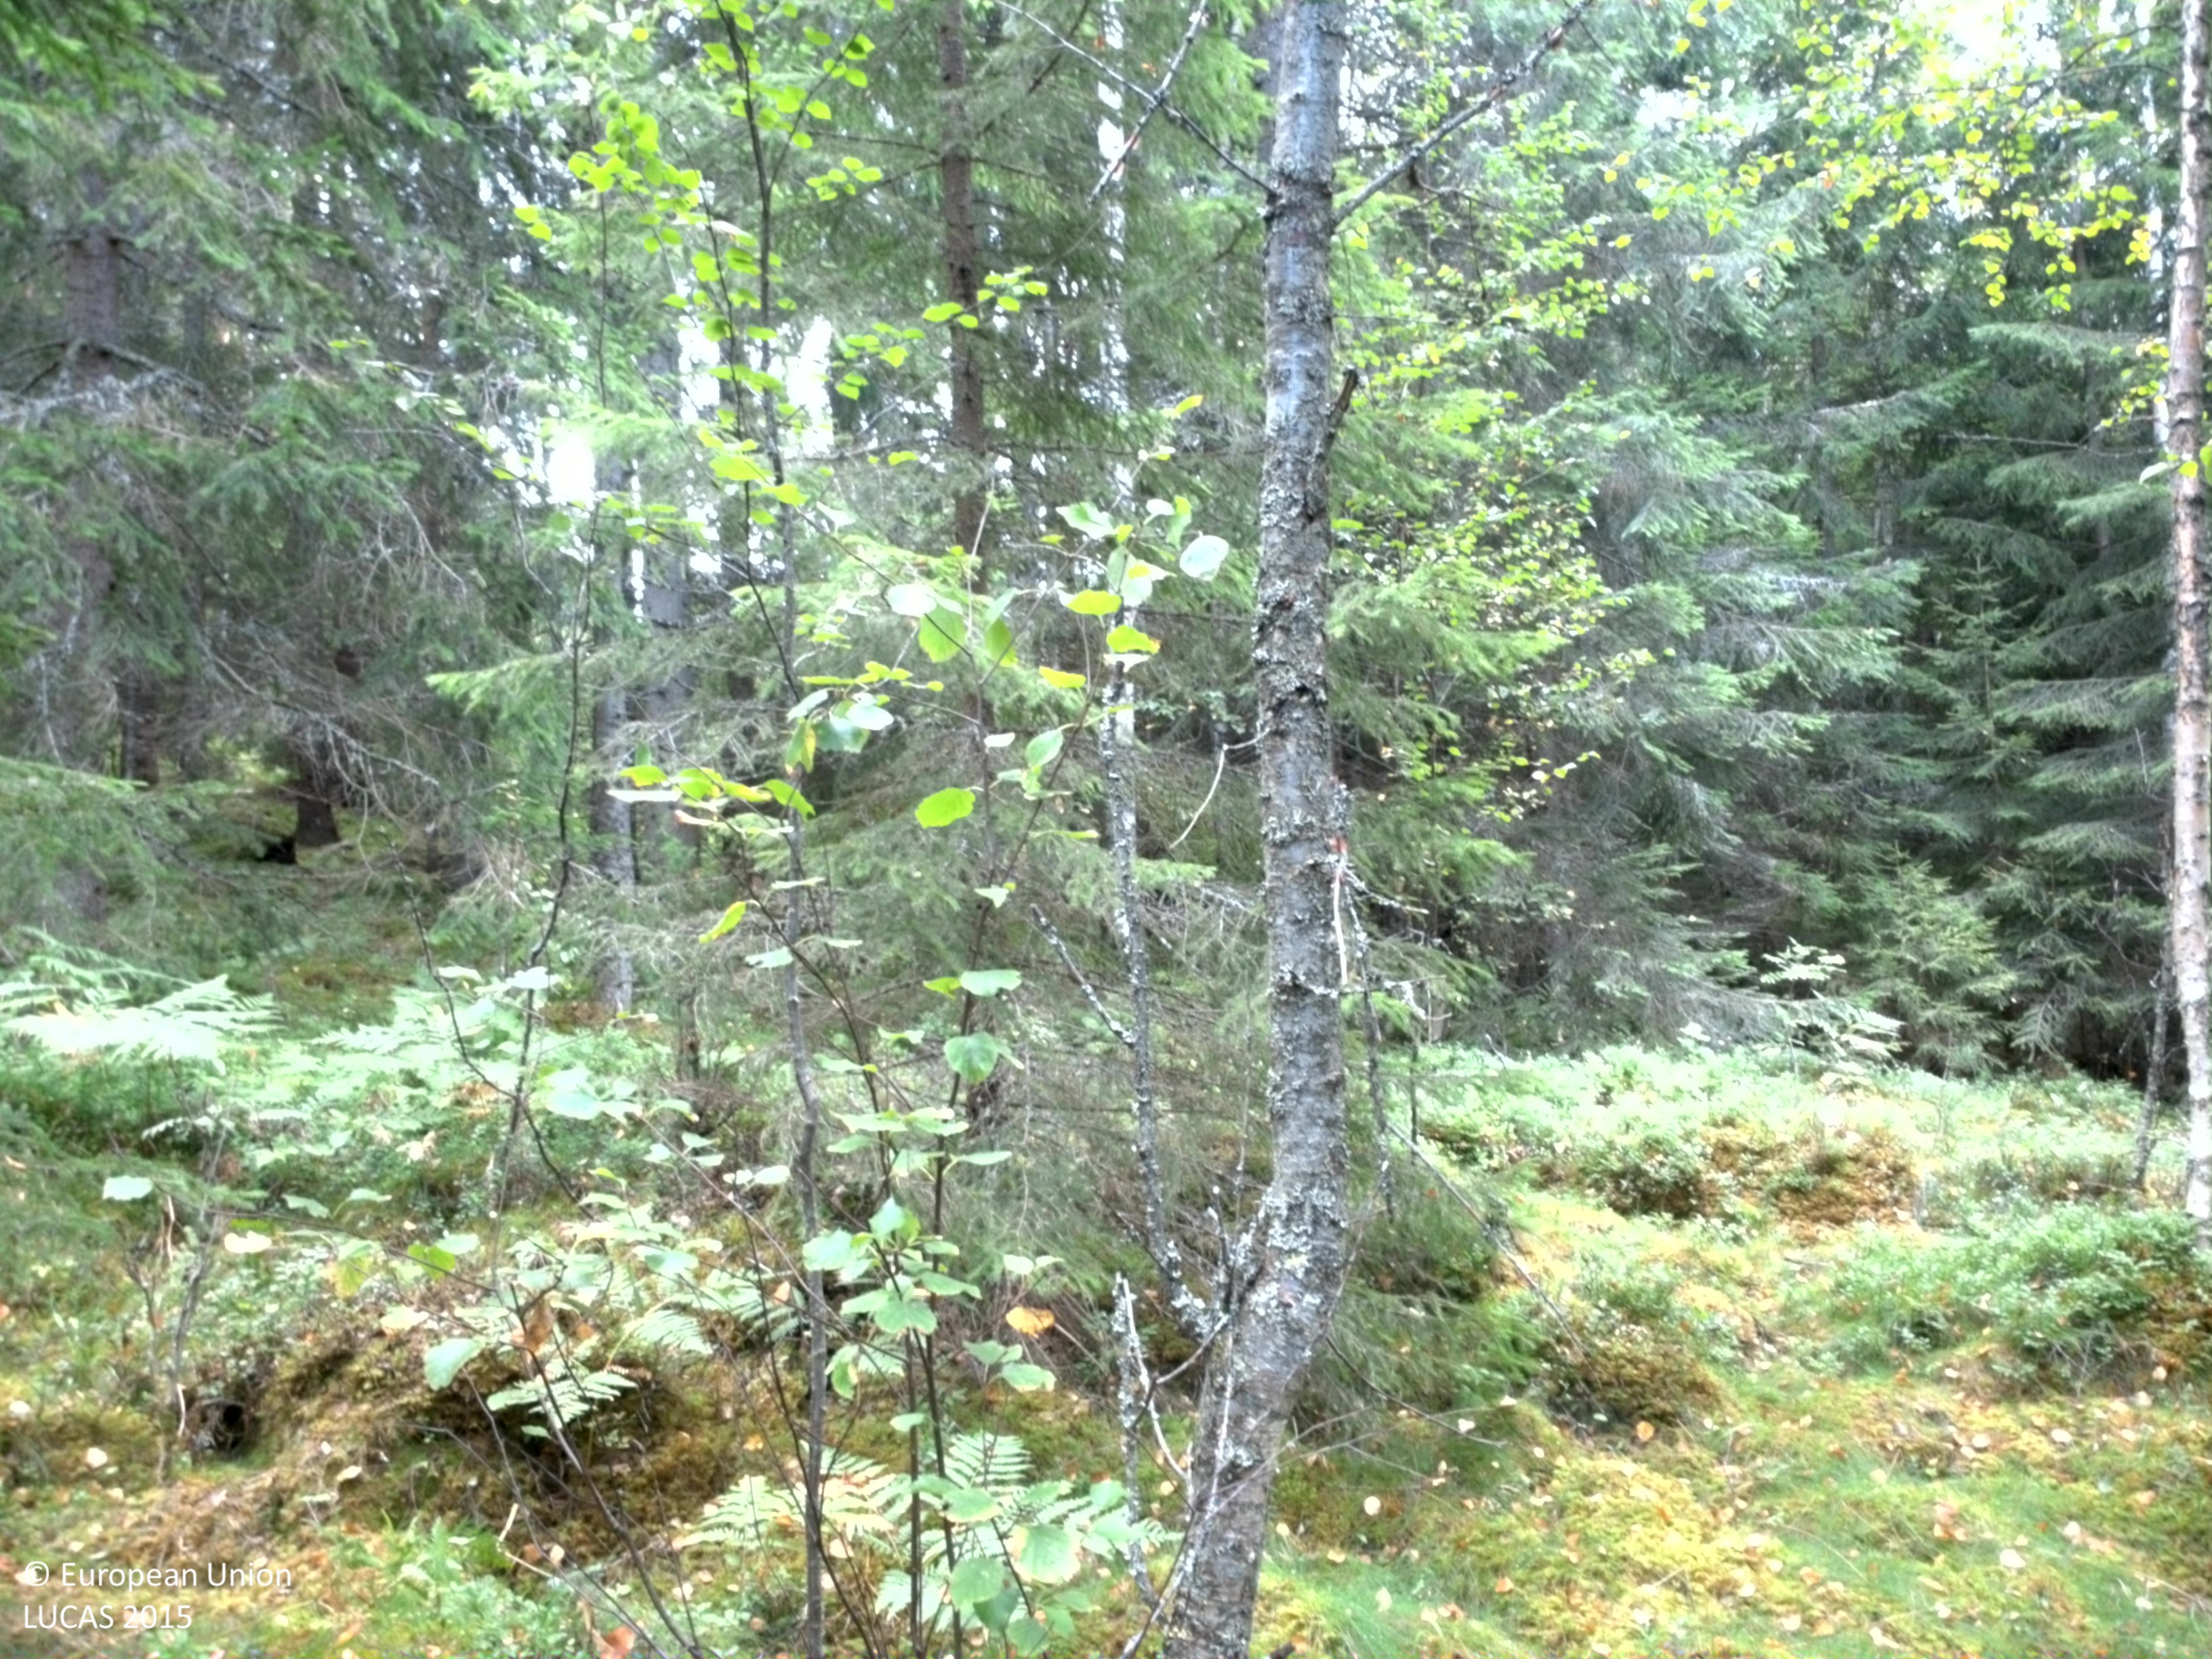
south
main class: Woodland
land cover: Spruce dominated mixed woodland
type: boreal forest
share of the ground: 50 - 75 %
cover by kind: coniferous forest trees 45 %, broadleaved forest trees 20 %, herbaceous plants 15 %, lichens and mosses 15 %, shrubs 5 %
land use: Forestry
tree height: > 5 m
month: August
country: SE
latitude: 59.6888
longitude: 13.4200
